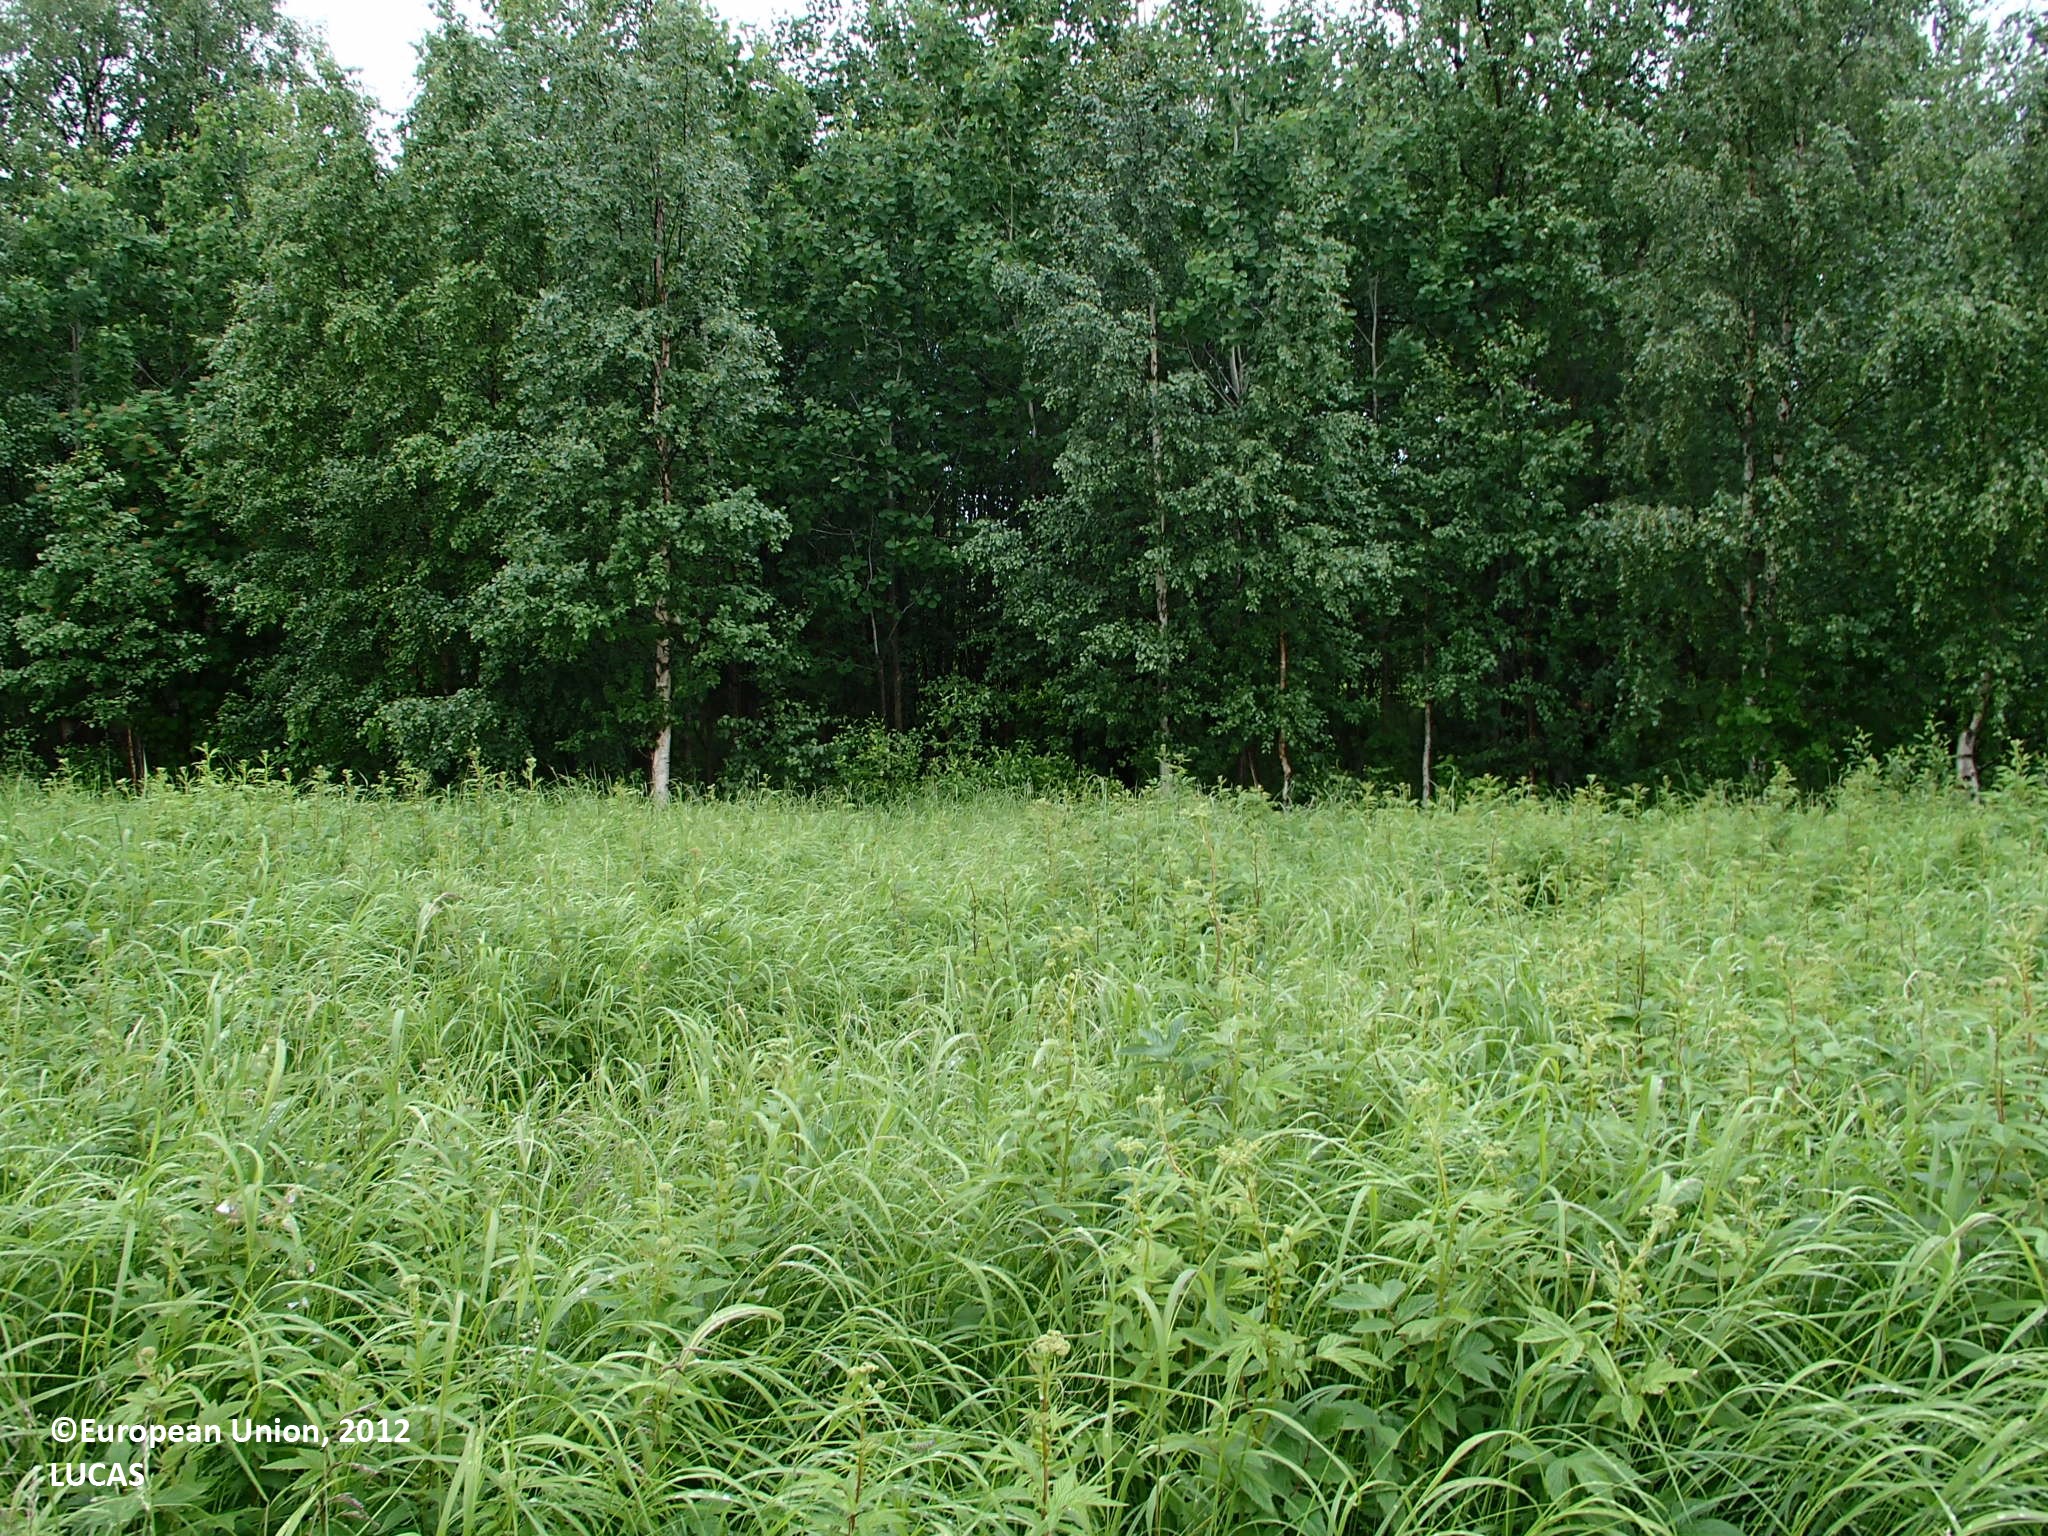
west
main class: Grassland
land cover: Grassland without tree/shrub cover
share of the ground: > 75 %
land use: Amenities, museums, leisure
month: July
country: FI
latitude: 66.9875
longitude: 27.5522
